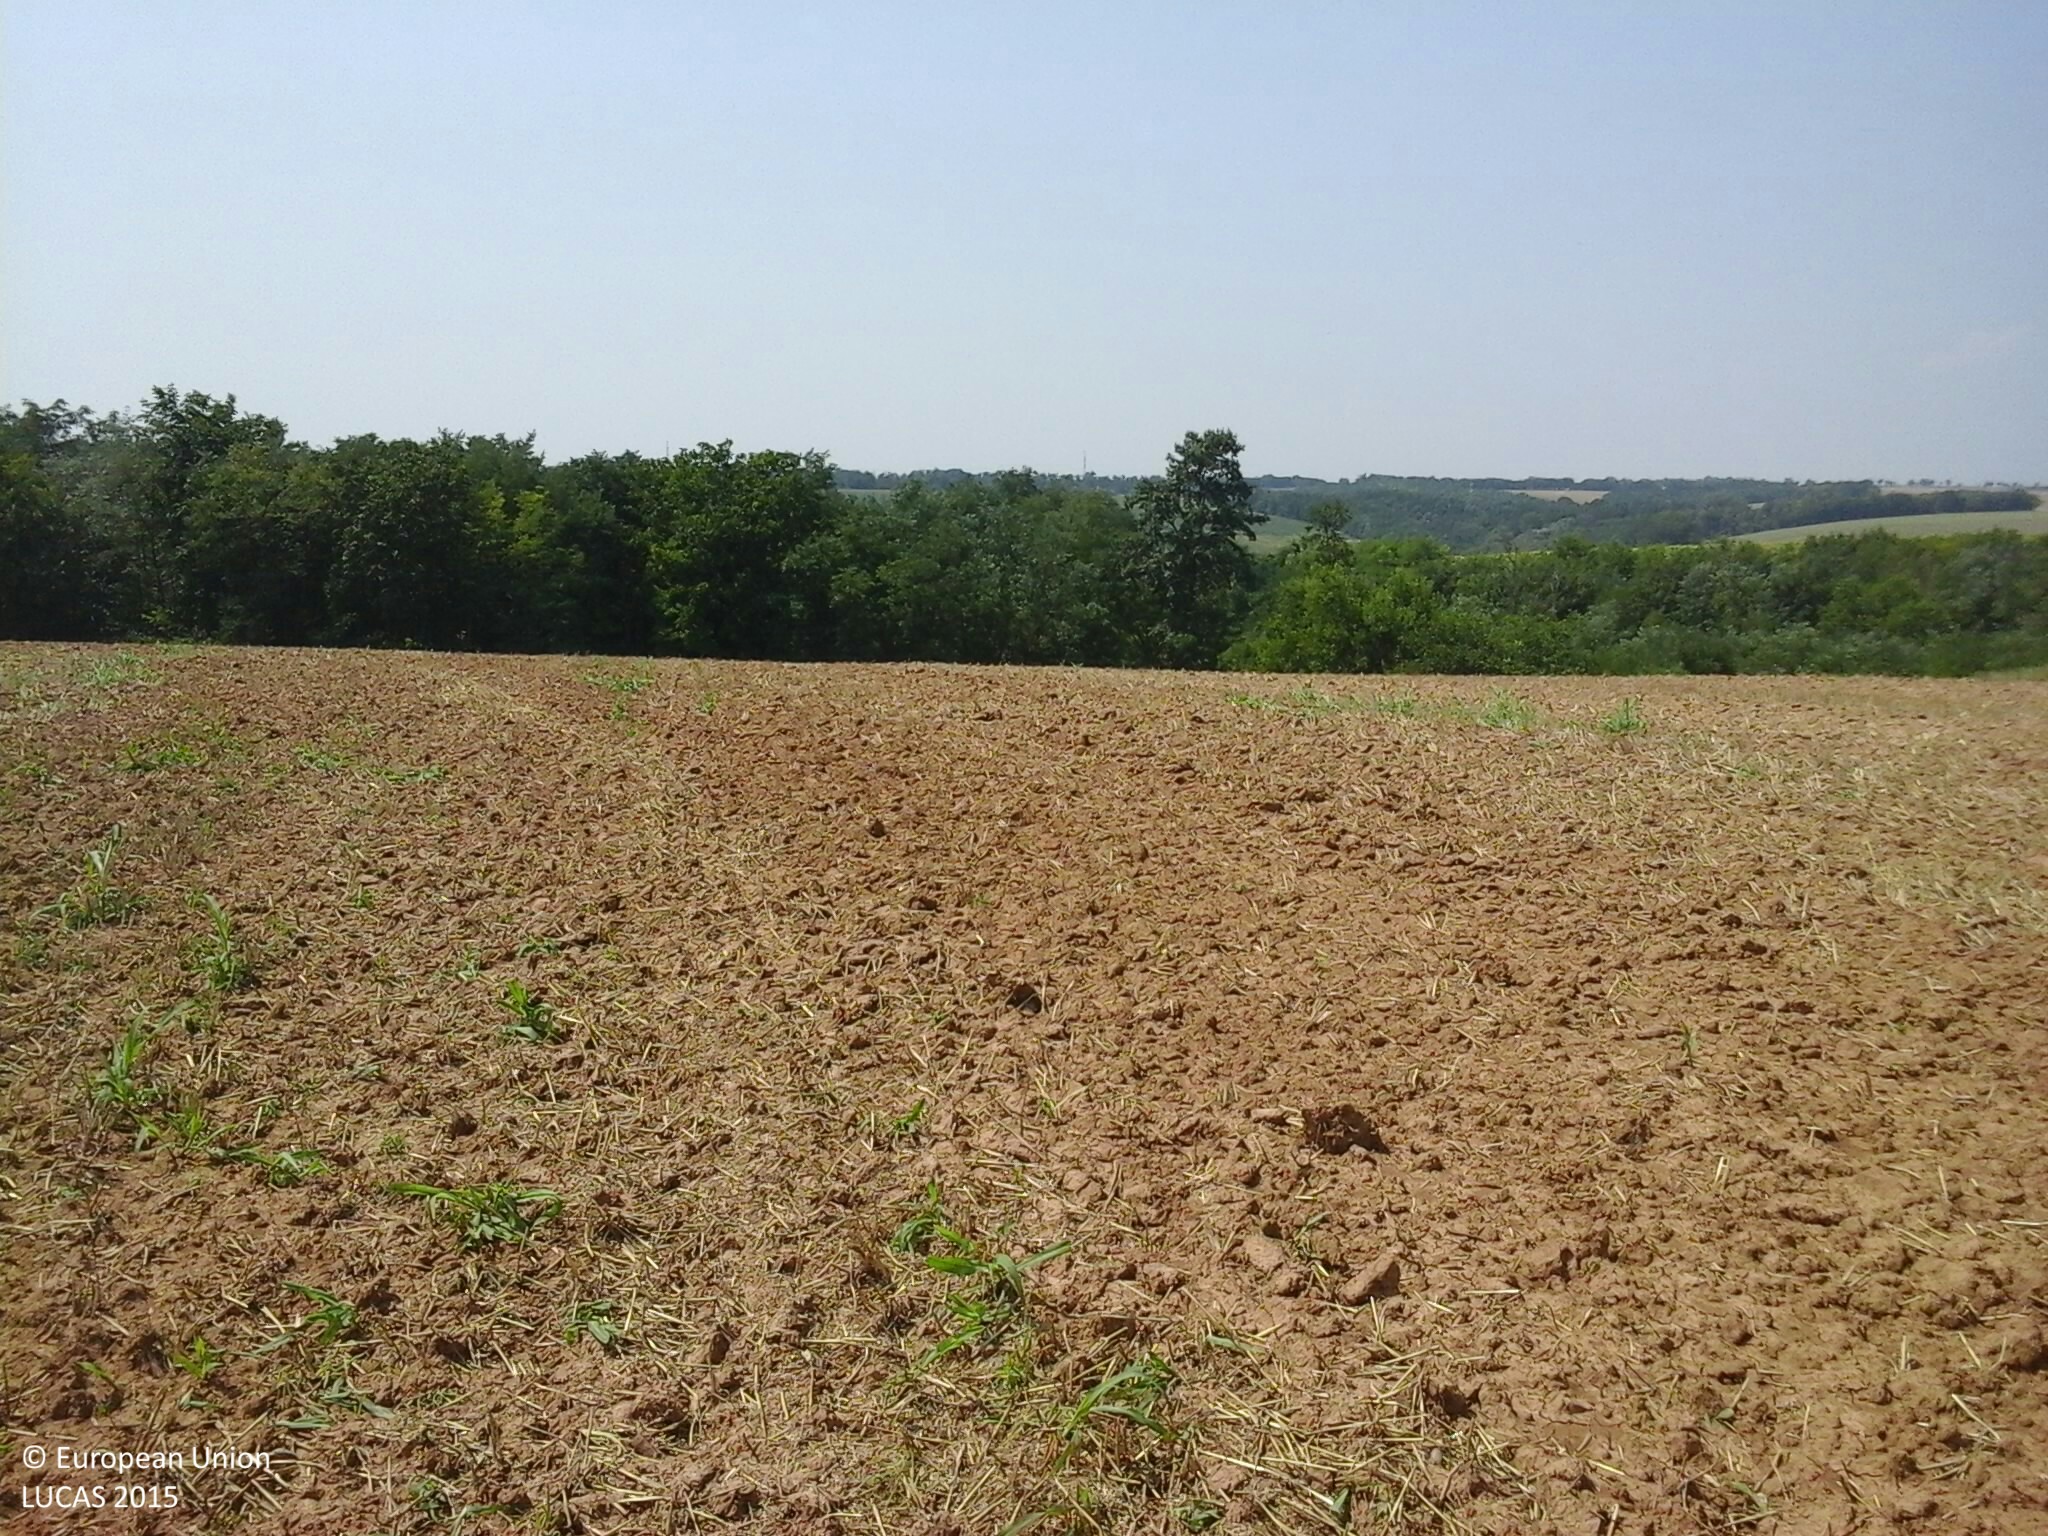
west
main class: Cropland
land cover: Common wheat
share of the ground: < 10 %
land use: Agriculture (excluding fallow land and kitchen gardens)
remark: Harvested field
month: August
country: HU
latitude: 45.9873
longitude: 18.3600
